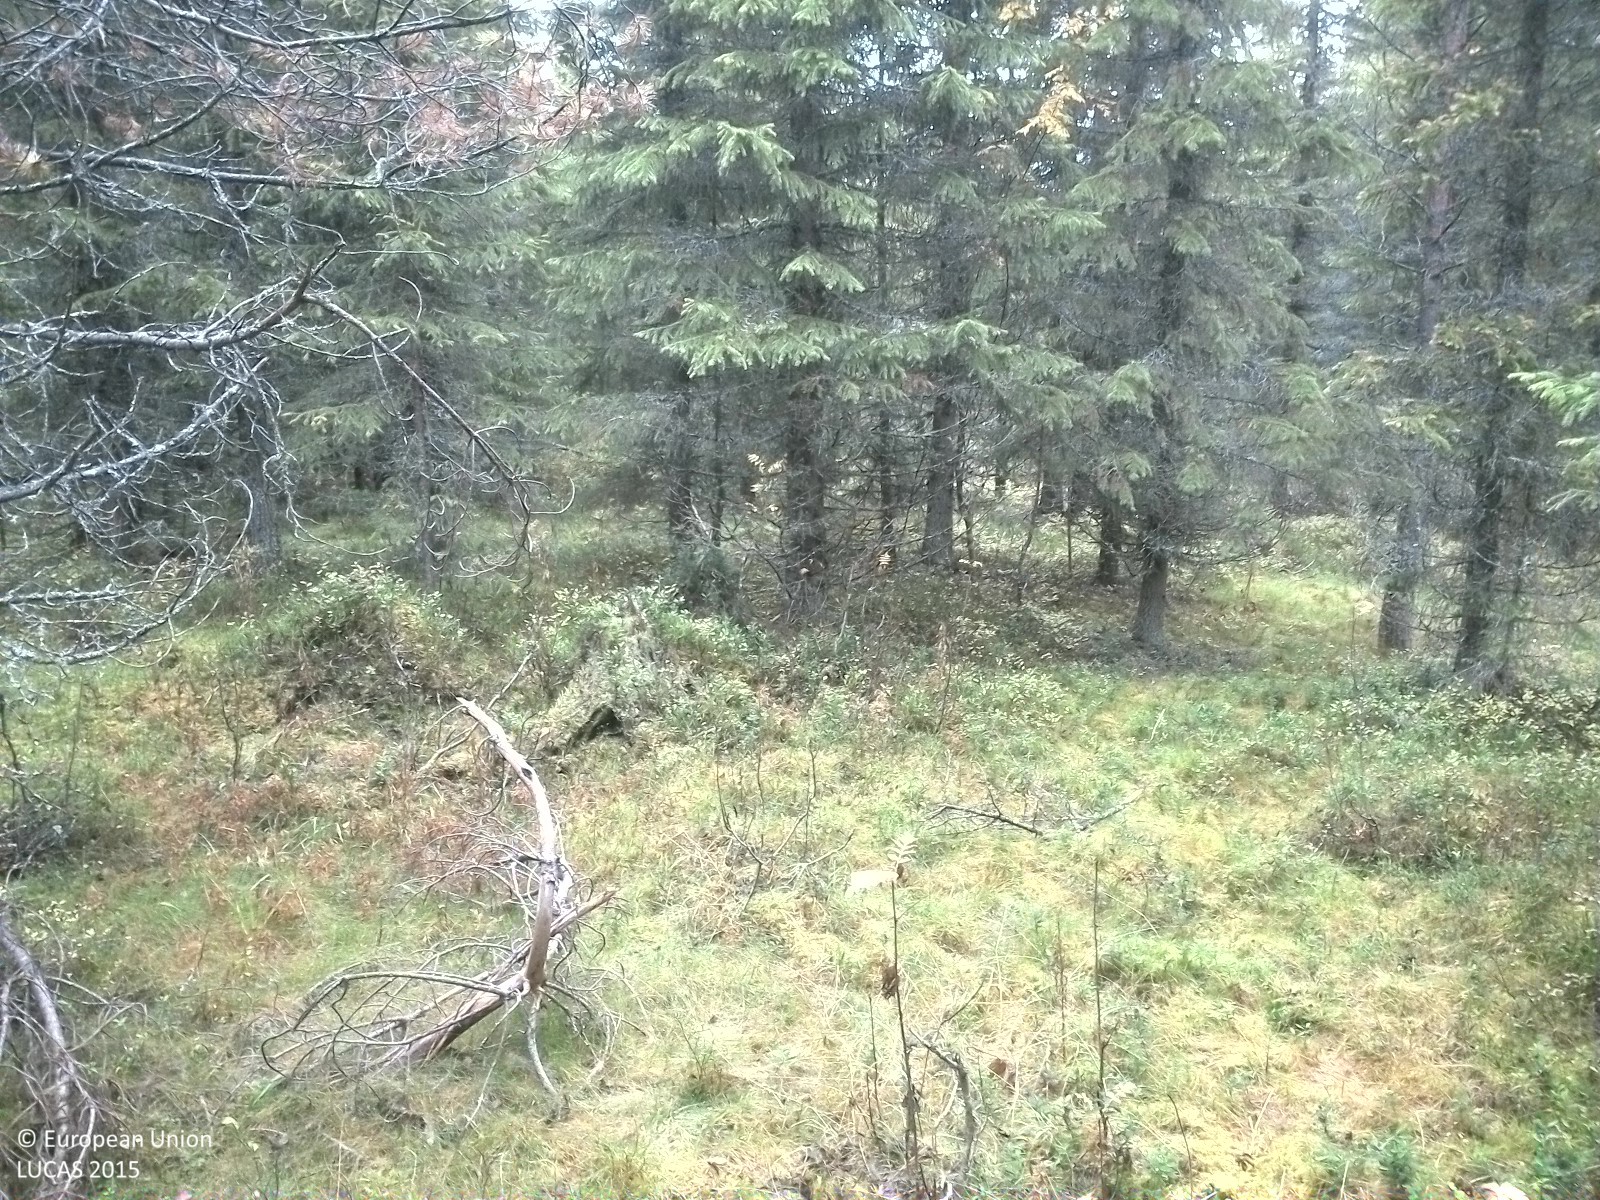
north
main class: Woodland
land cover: Spruce dominated mixed woodland
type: boreal forest
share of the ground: > 75 %
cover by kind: coniferous forest trees 60 %, broadleaved forest trees 20 %, shrubs 20 %
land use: Forestry
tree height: > 5 m
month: October
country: SE
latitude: 63.5960
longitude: 14.9946
